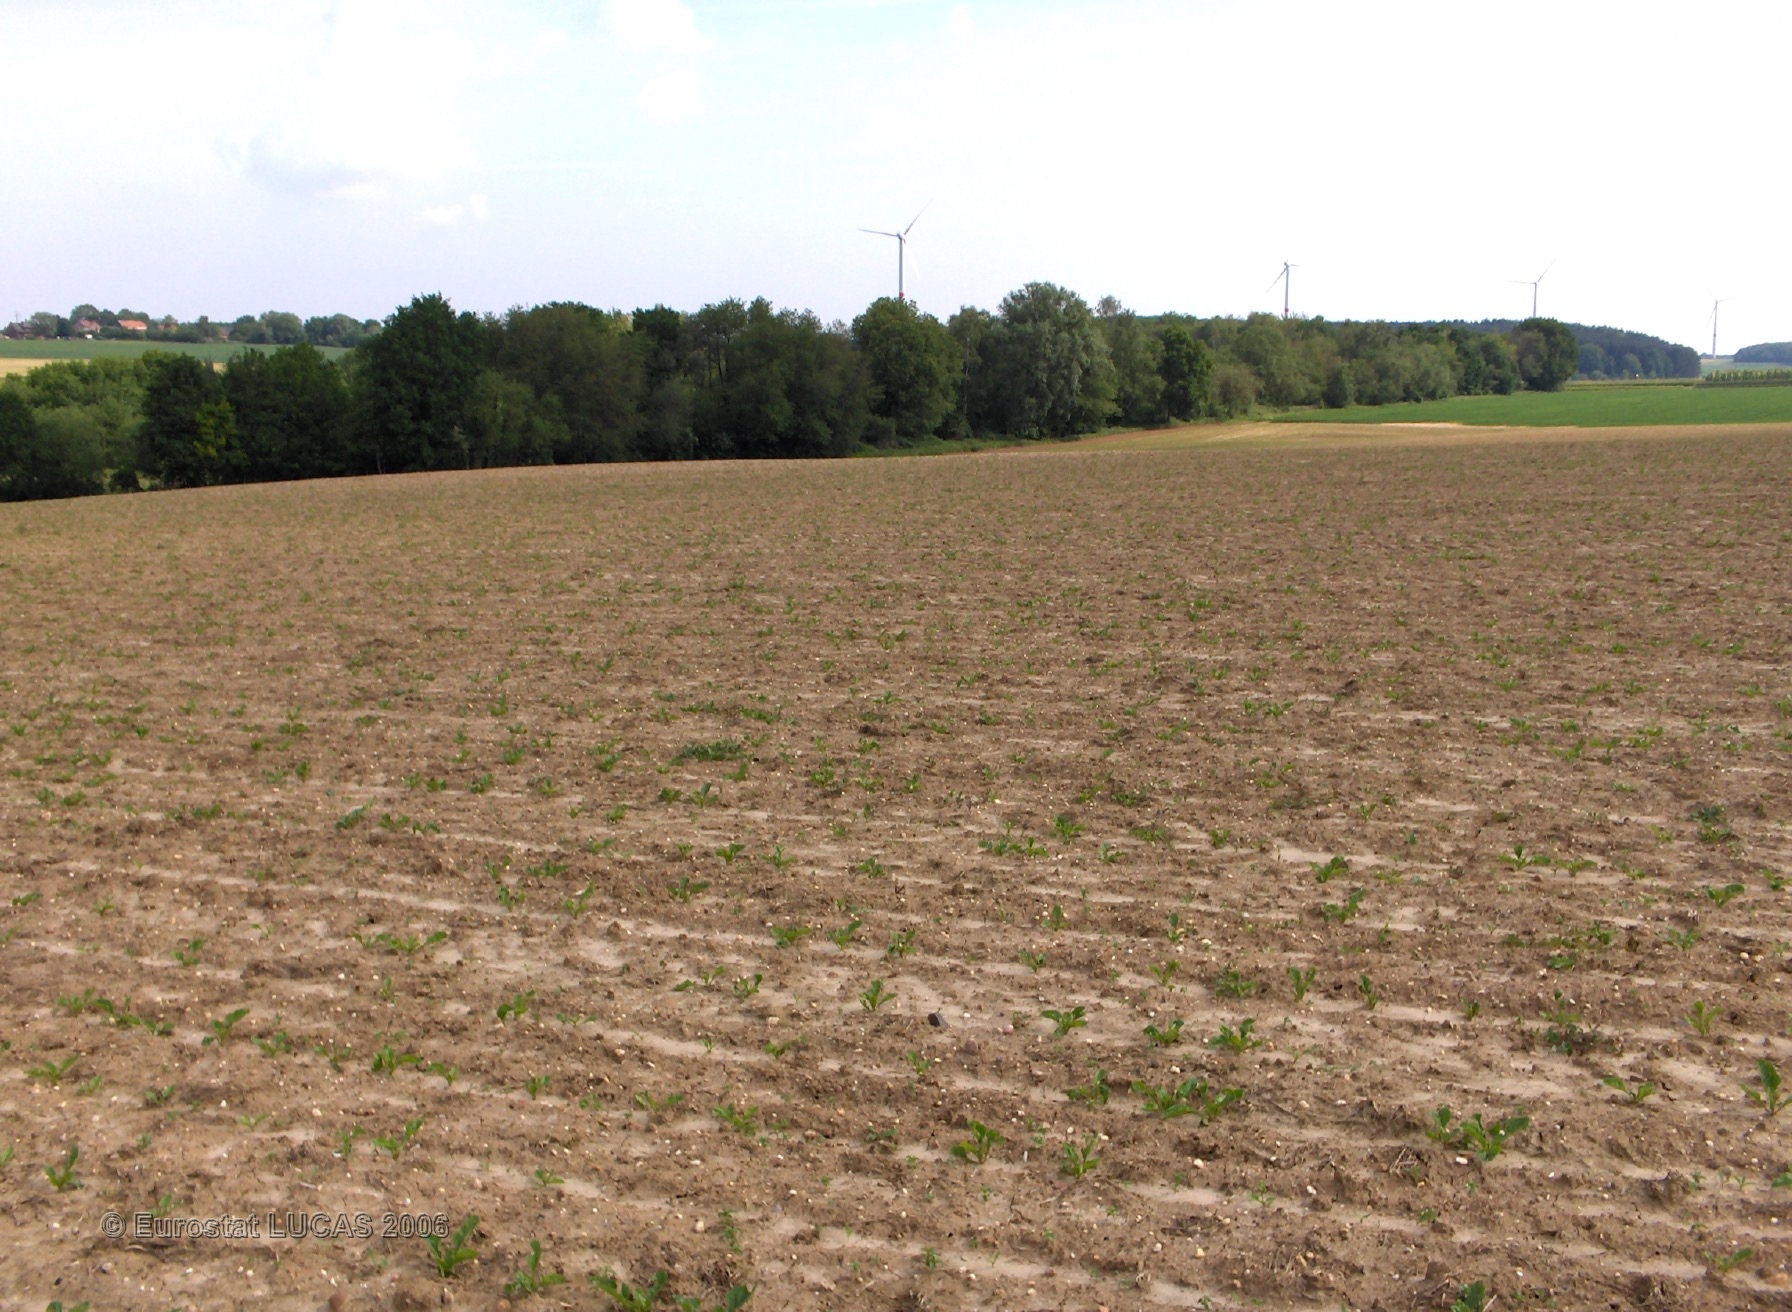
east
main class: Cropland
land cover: Sugar beet
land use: Agriculture (excluding fallow land and kitchen gardens)
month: May
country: BE
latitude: 50.5700
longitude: 5.2112
